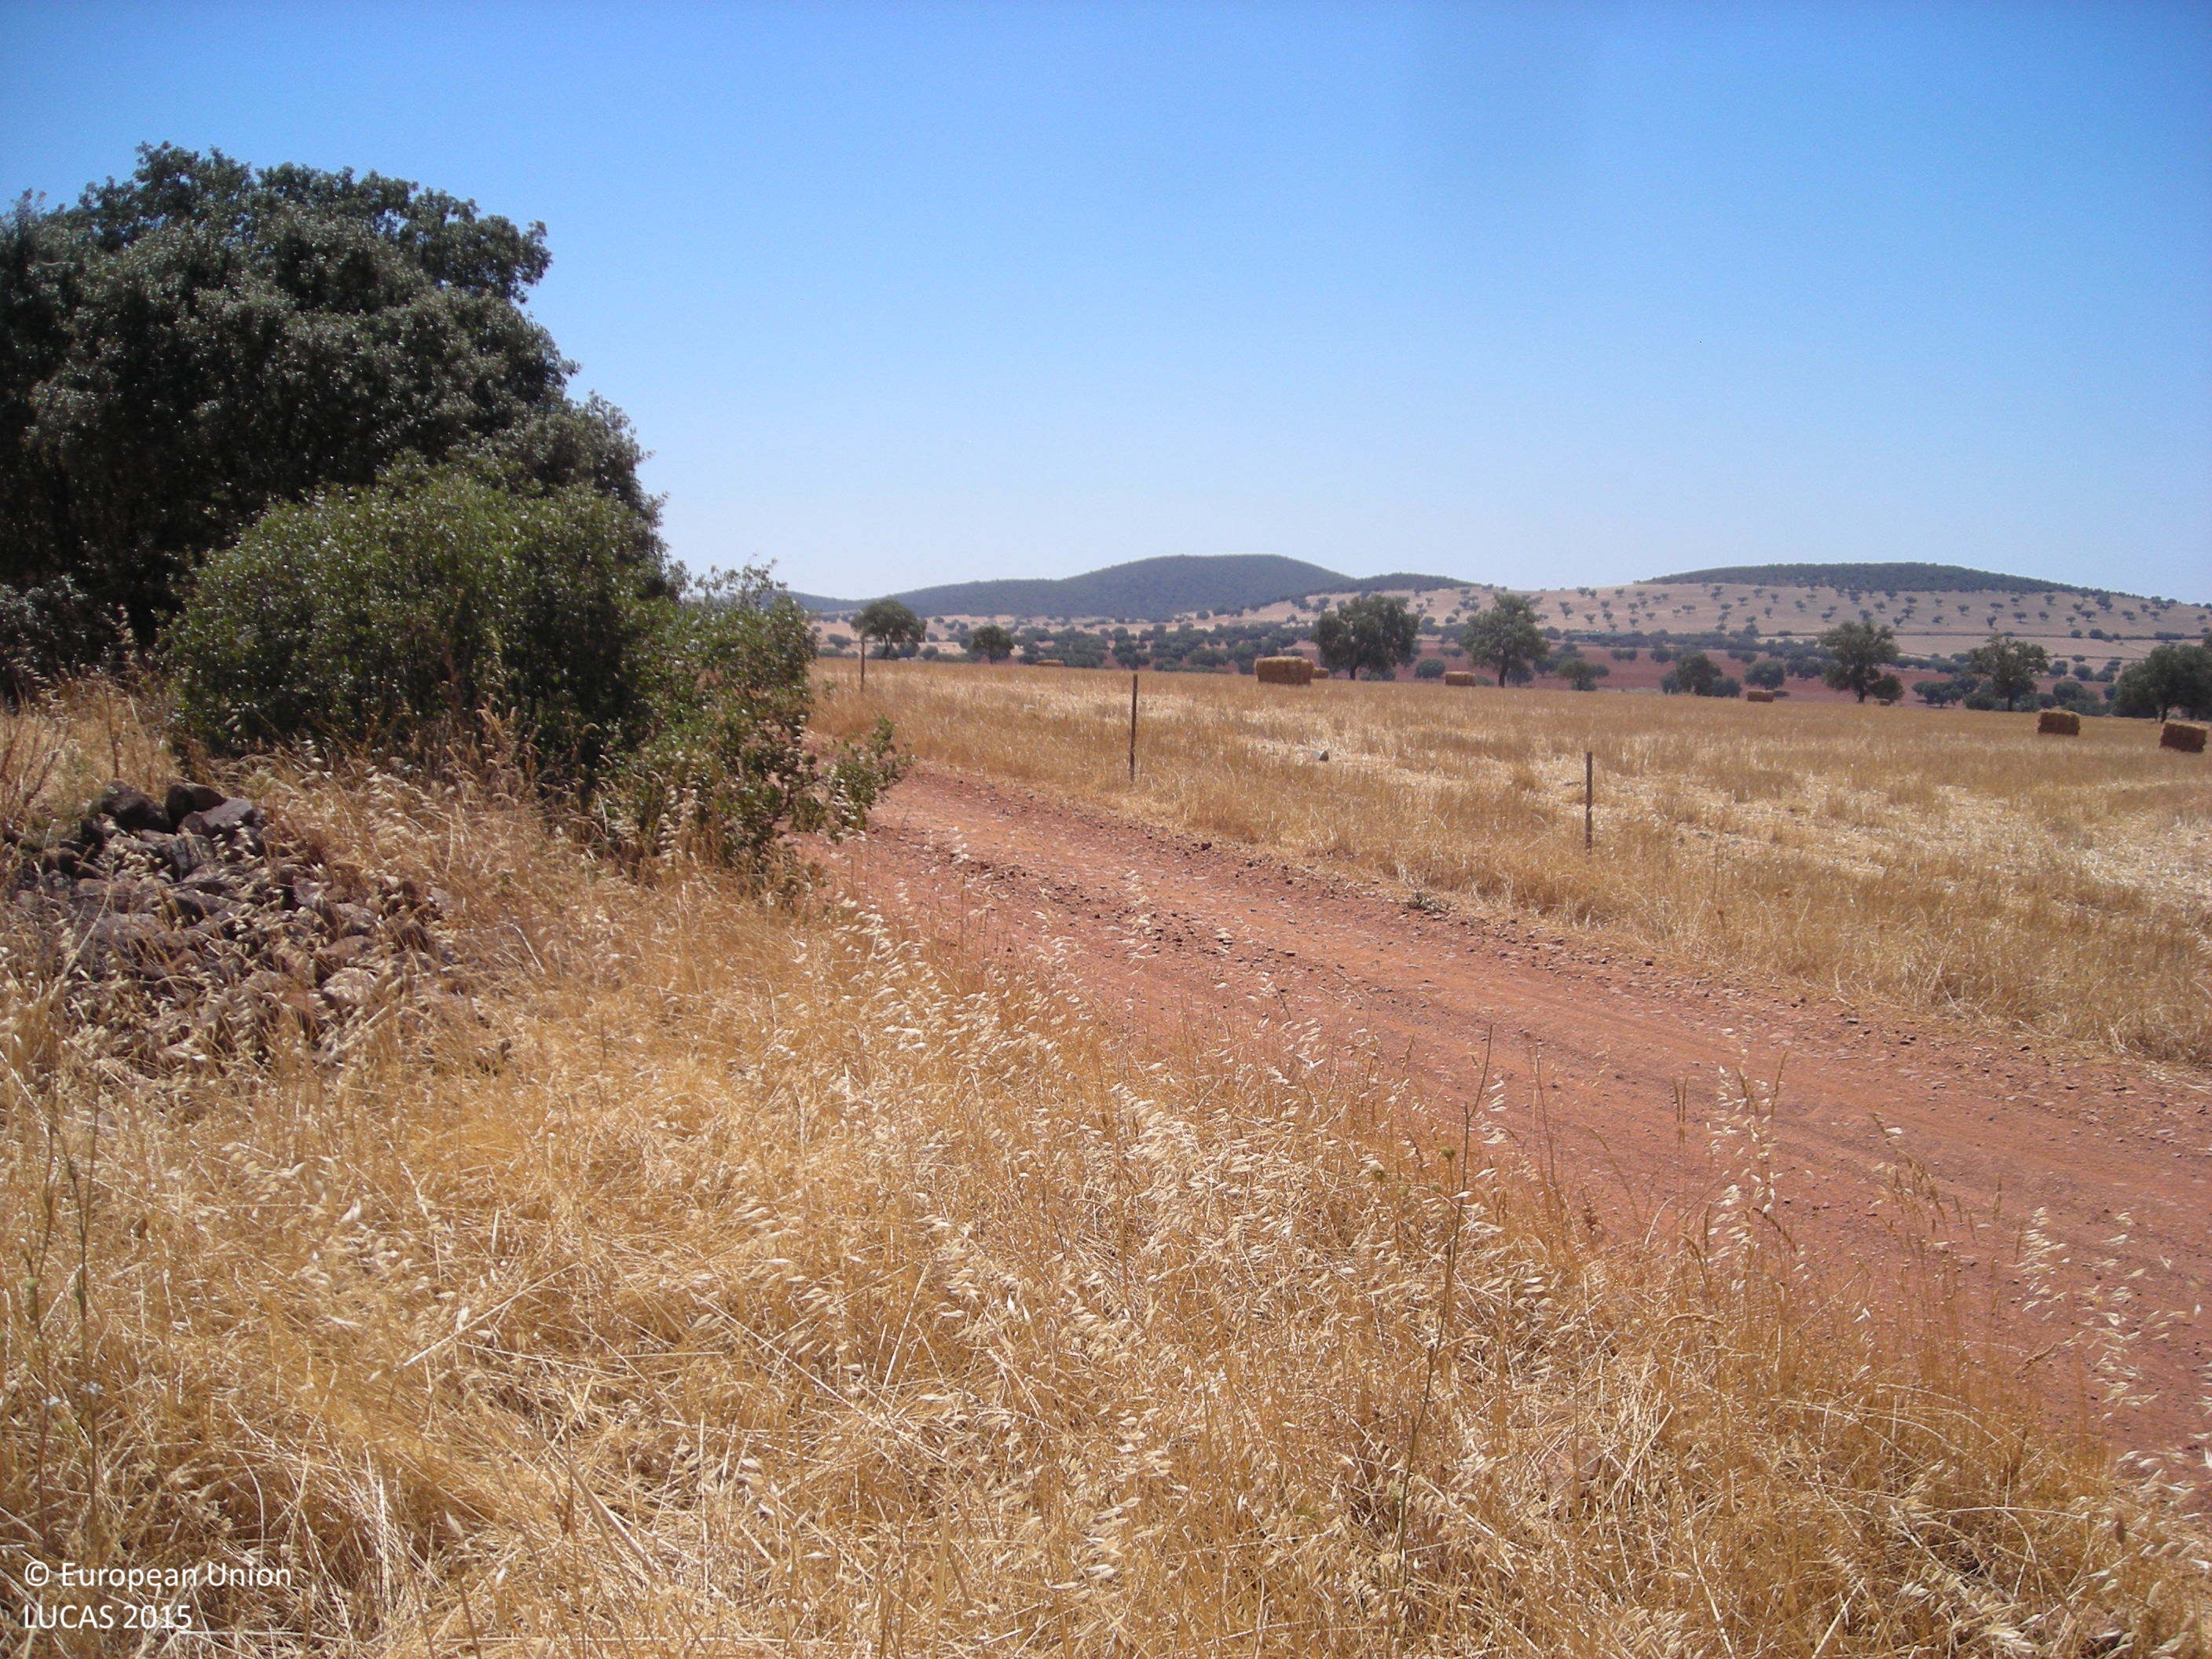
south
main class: Grassland
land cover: Grassland with sparse tree/shrub cover
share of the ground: > 75 %
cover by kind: herbaceous plants 85 %, shrubs 10 %, broadleaved forest trees 5 %
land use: Agriculture (excluding fallow land and kitchen gardens)
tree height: > 5 m
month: July
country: ES
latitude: 38.7032
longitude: -5.9026
